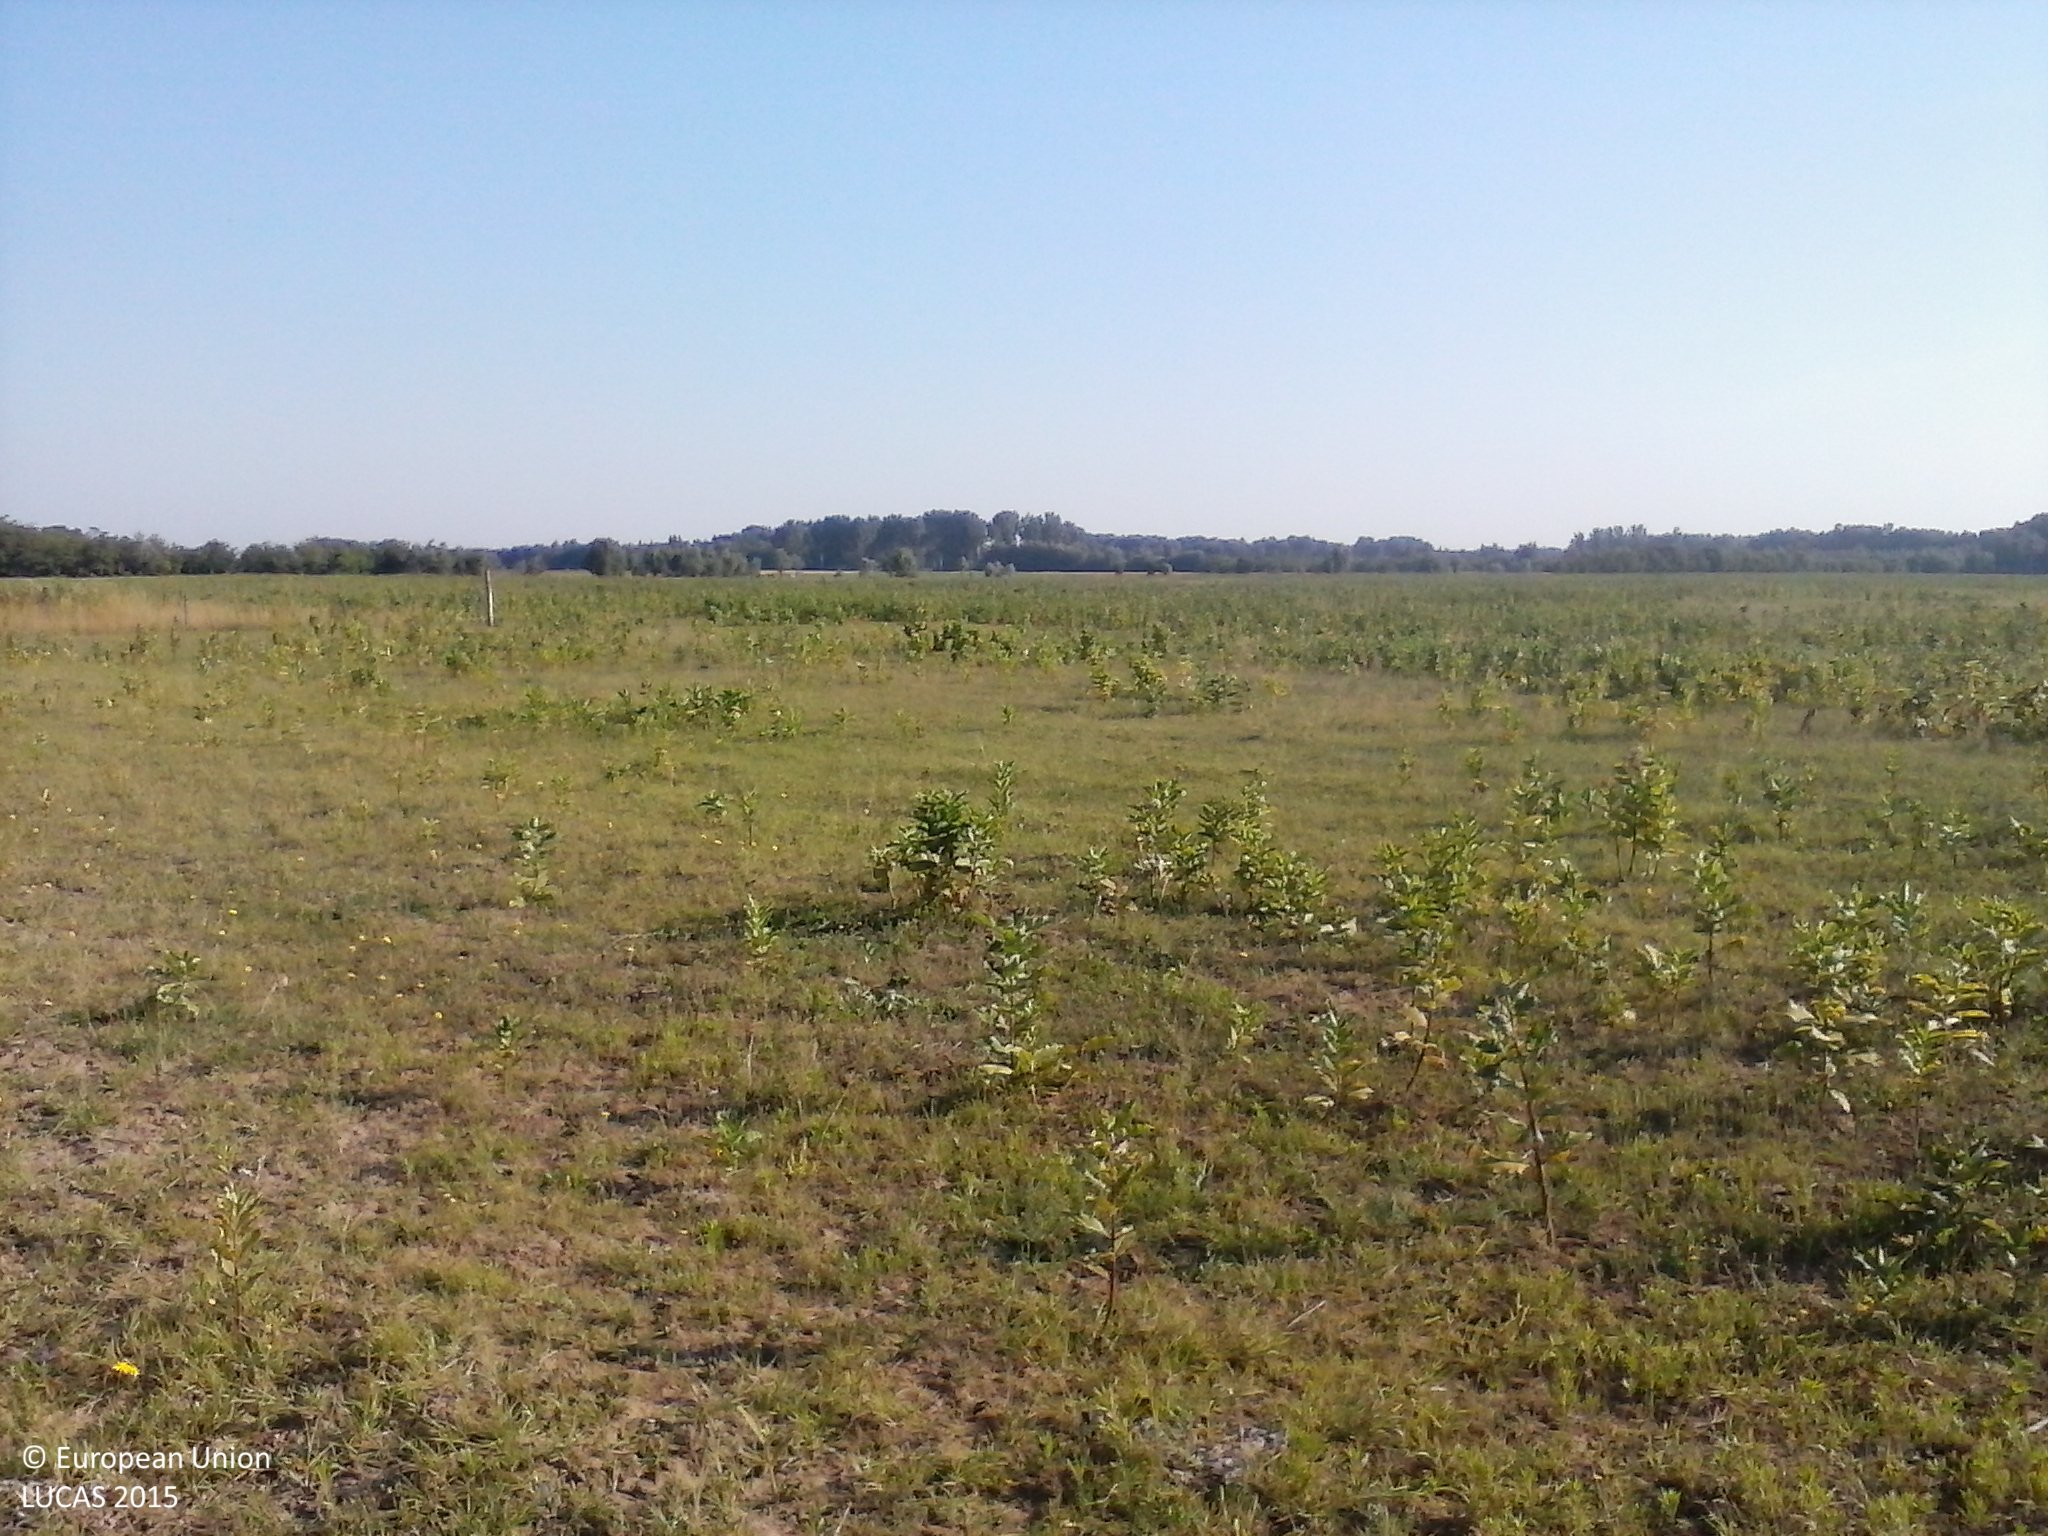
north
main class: Grassland
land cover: Spontaneously vegetated surfaces
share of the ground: > 75 %
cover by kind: herbaceous plants 90 %, unconsolidated bare surface 10 %
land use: Agriculture (excluding fallow land and kitchen gardens)
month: July
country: HU
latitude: 46.3339
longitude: 19.6179
